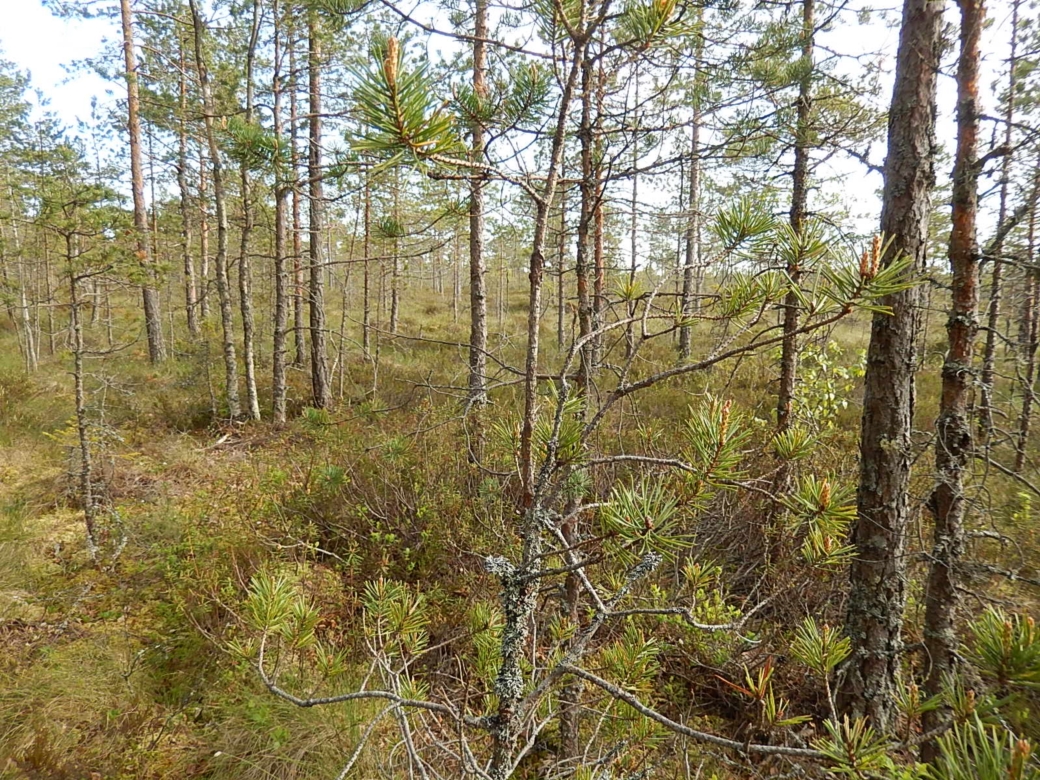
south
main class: Woodland
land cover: Pine dominated mixed woodland
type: boreal forest
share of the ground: > 75 %
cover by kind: coniferous forest trees 50 %, broadleaved forest trees 30 %, shrubs 10 %, herbaceous plants 10 %
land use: Forestry
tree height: > 5 m
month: June
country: FI
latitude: 61.9480
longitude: 21.5418
